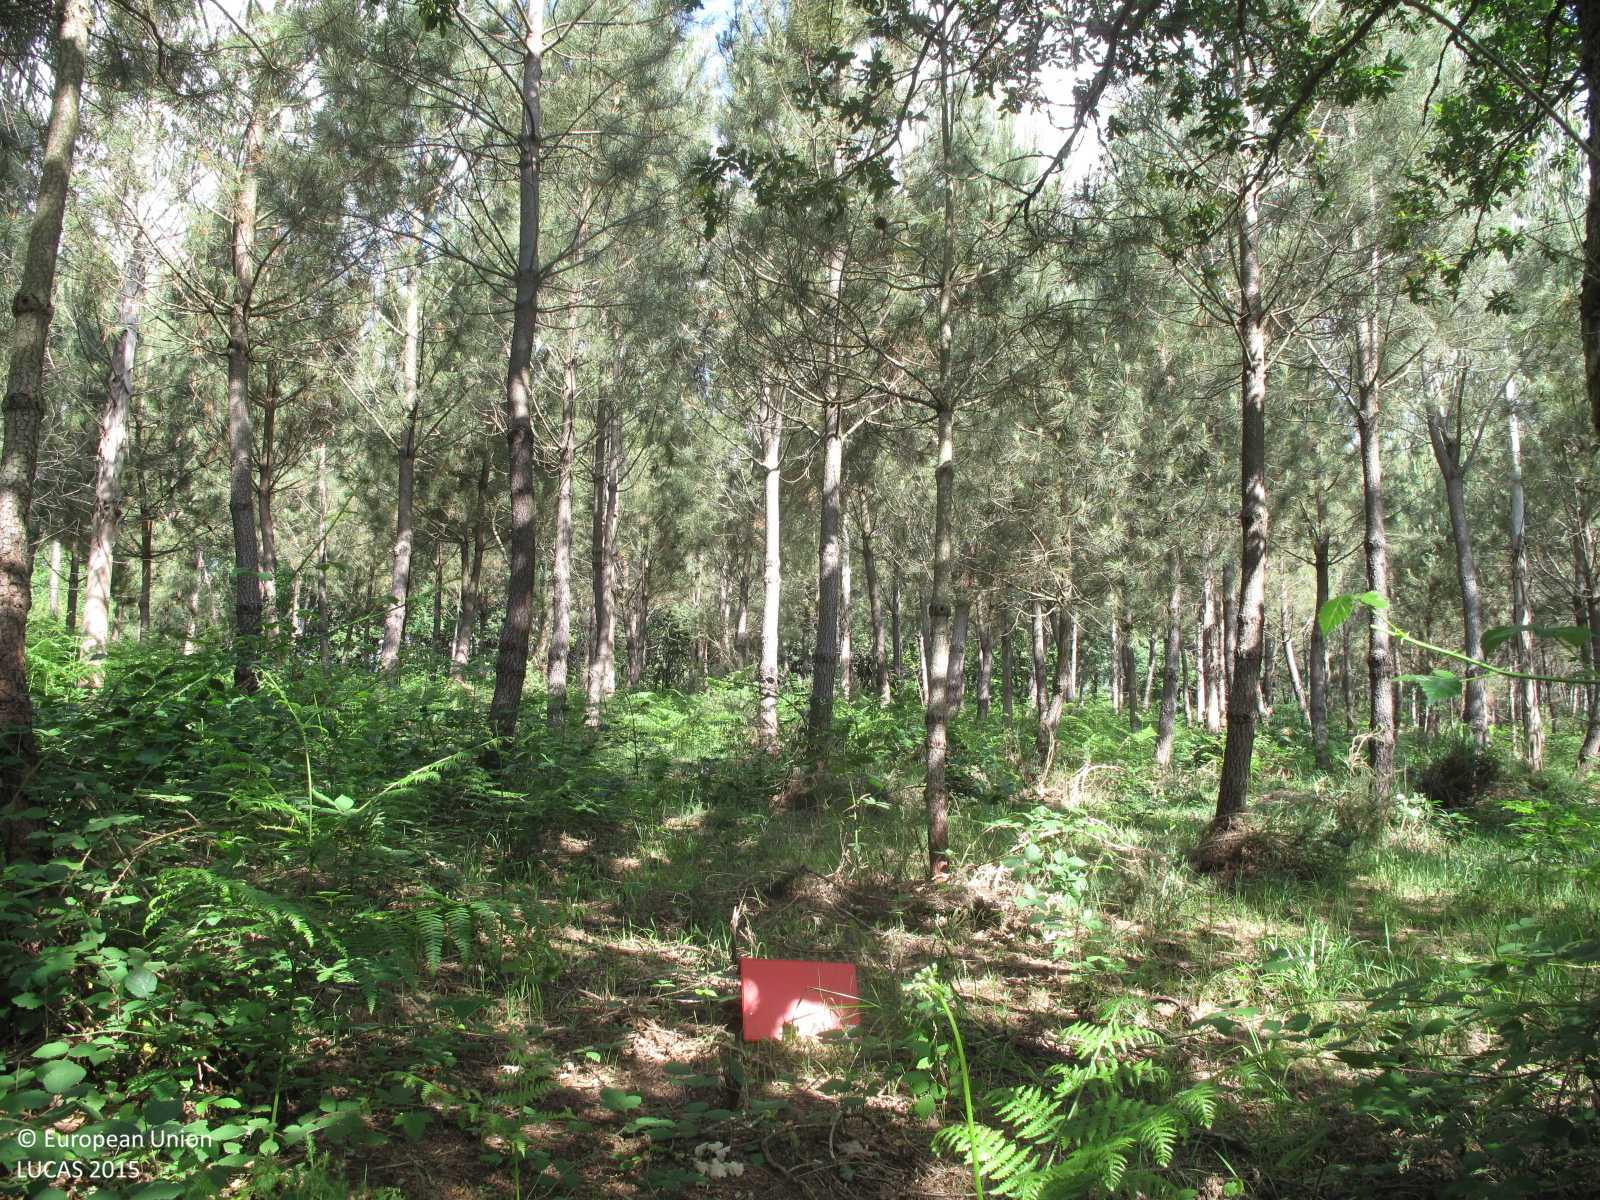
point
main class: Woodland
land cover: Other mixed woodland
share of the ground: > 75 %
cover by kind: coniferous forest trees 50 %, broadleaved forest trees 40 %, shrubs 10 %
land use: Forestry
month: June
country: ES
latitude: 42.9809
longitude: -8.5118
